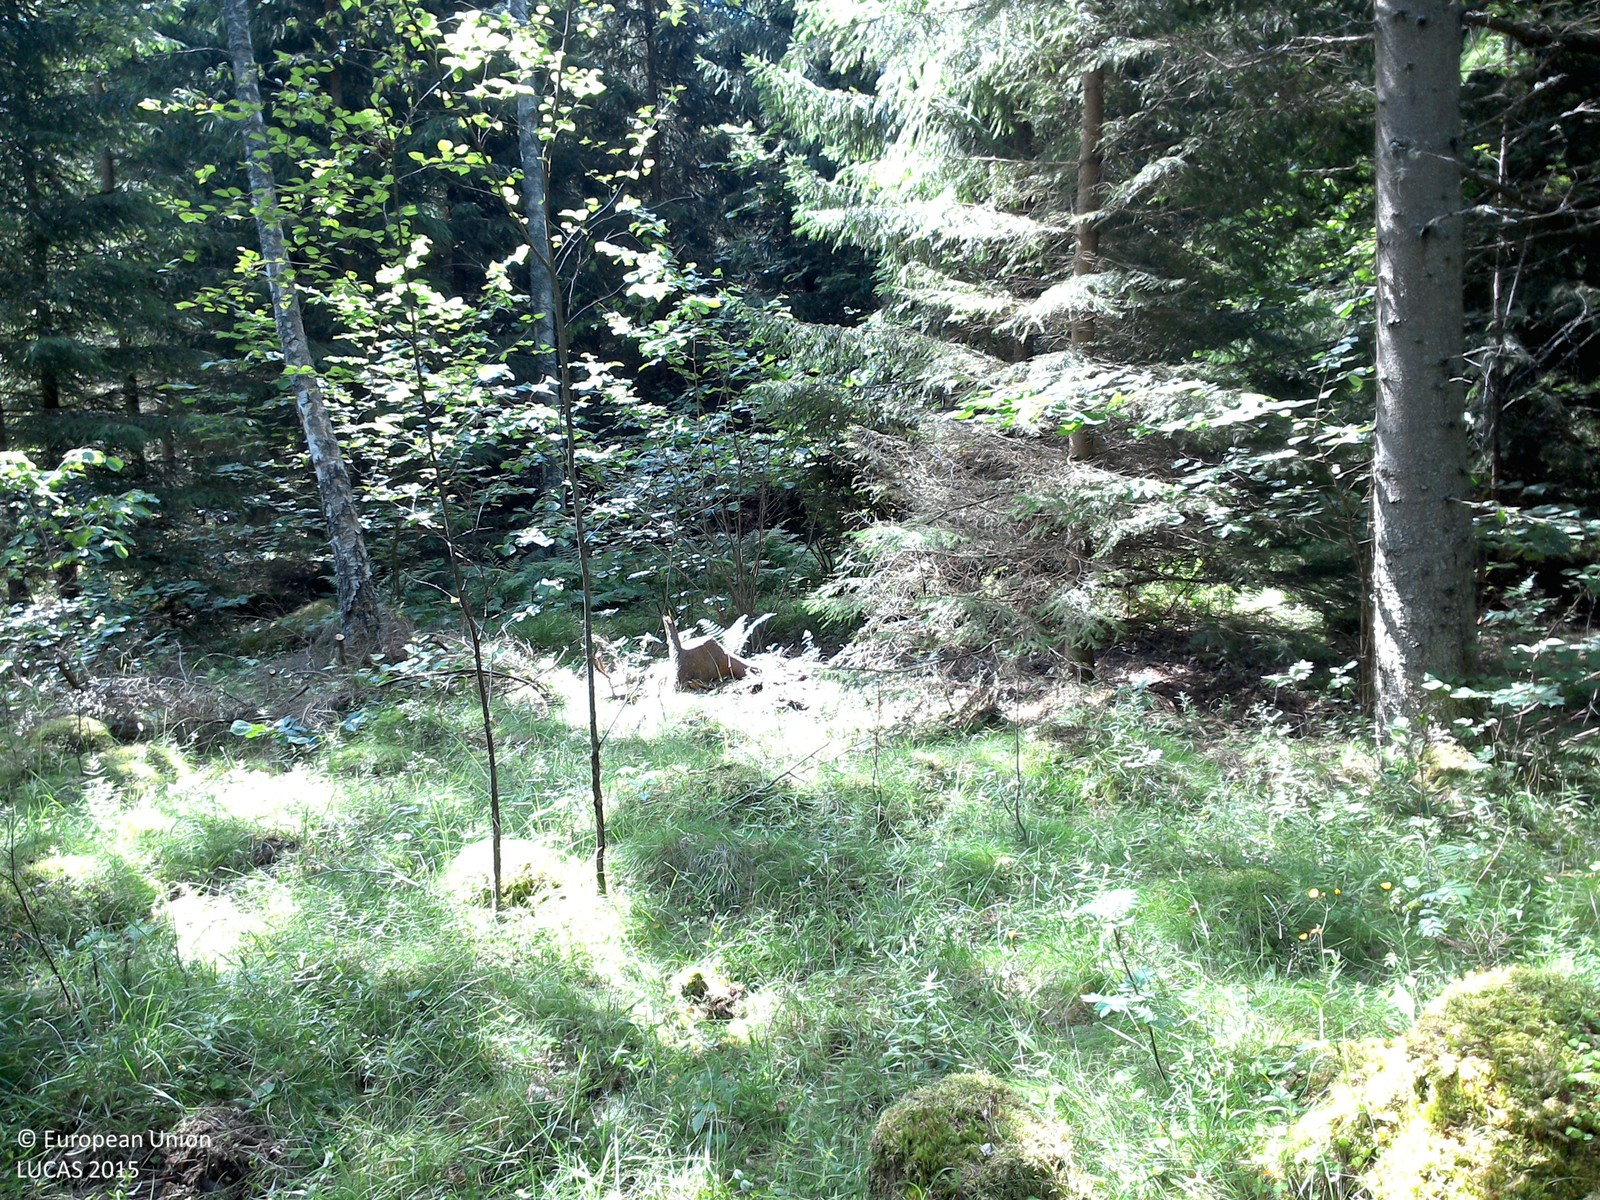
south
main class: Woodland
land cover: Spruce dominated mixed woodland
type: boreal forest
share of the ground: 50 - 75 %
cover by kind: coniferous forest trees 50 %, broadleaved forest trees 25 %, herbaceous plants 25 %
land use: Forestry
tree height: > 5 m
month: July
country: SE
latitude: 58.1062
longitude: 14.5592
